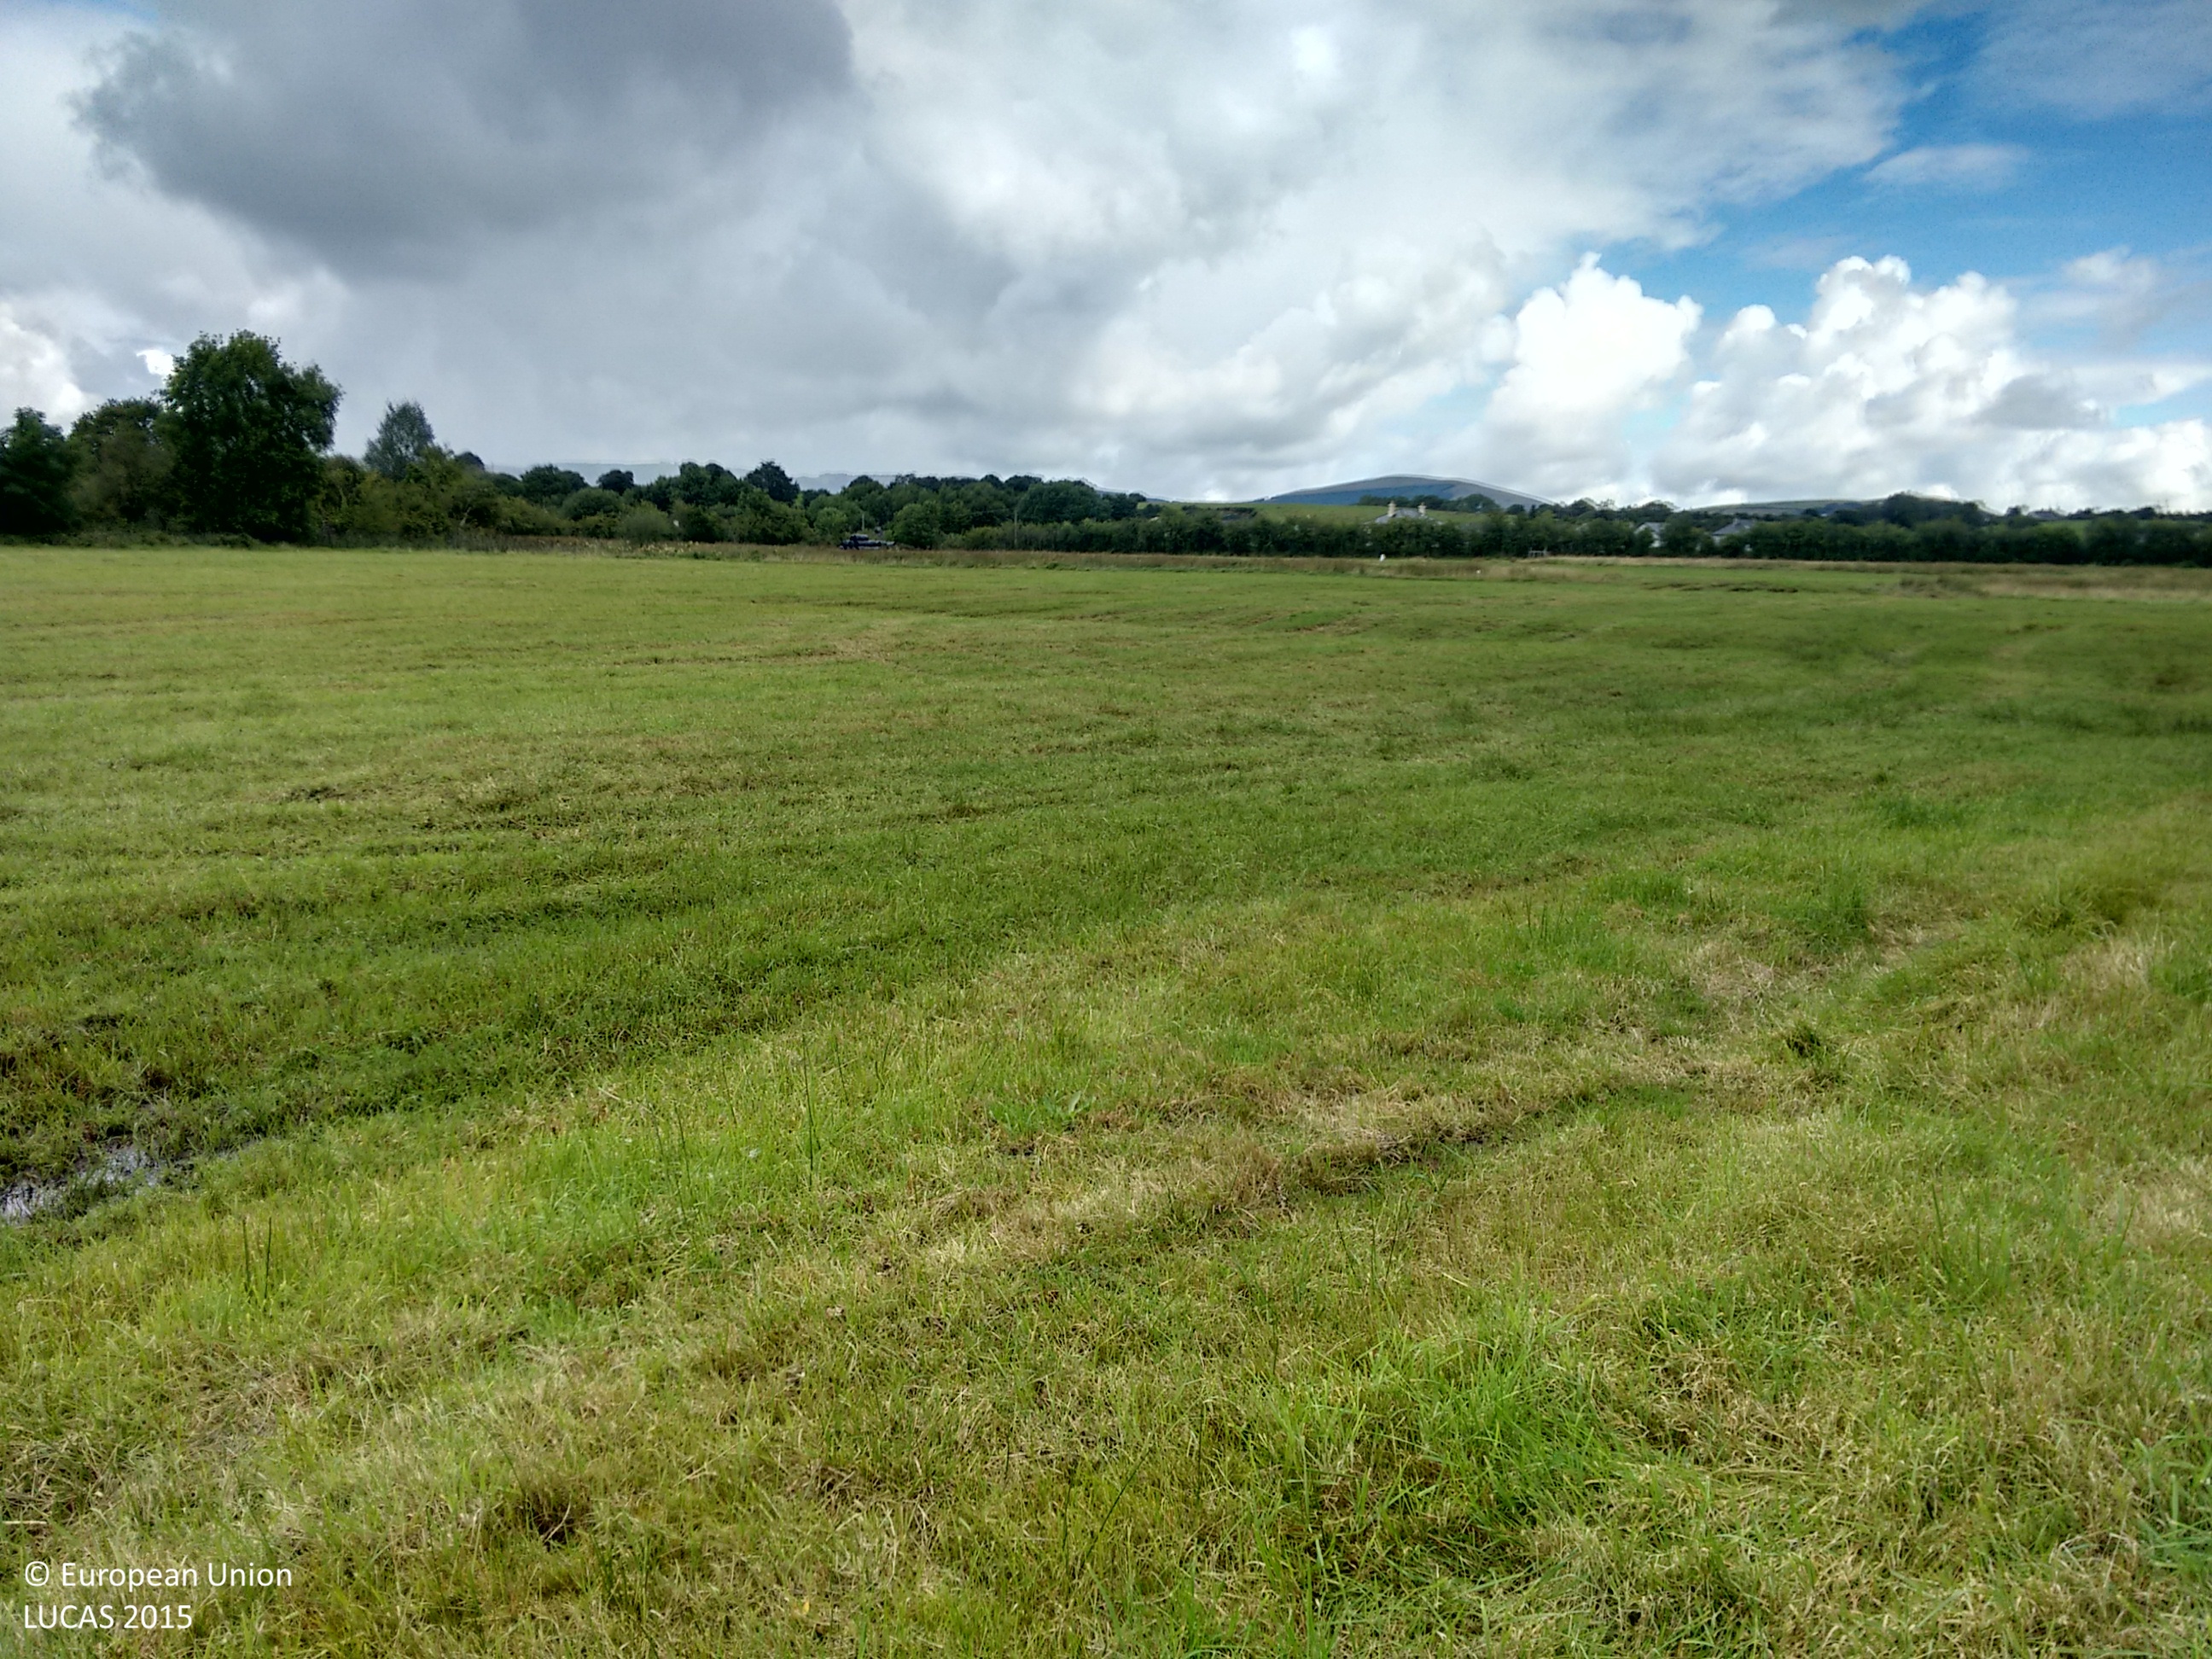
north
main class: Grassland
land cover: Grassland without tree/shrub cover
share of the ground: > 75 %
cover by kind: herbaceous plants 95 %, unconsolidated bare surface 5 %
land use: Agriculture (excluding fallow land and kitchen gardens)
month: August
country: IE
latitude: 52.6028
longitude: -8.2732
